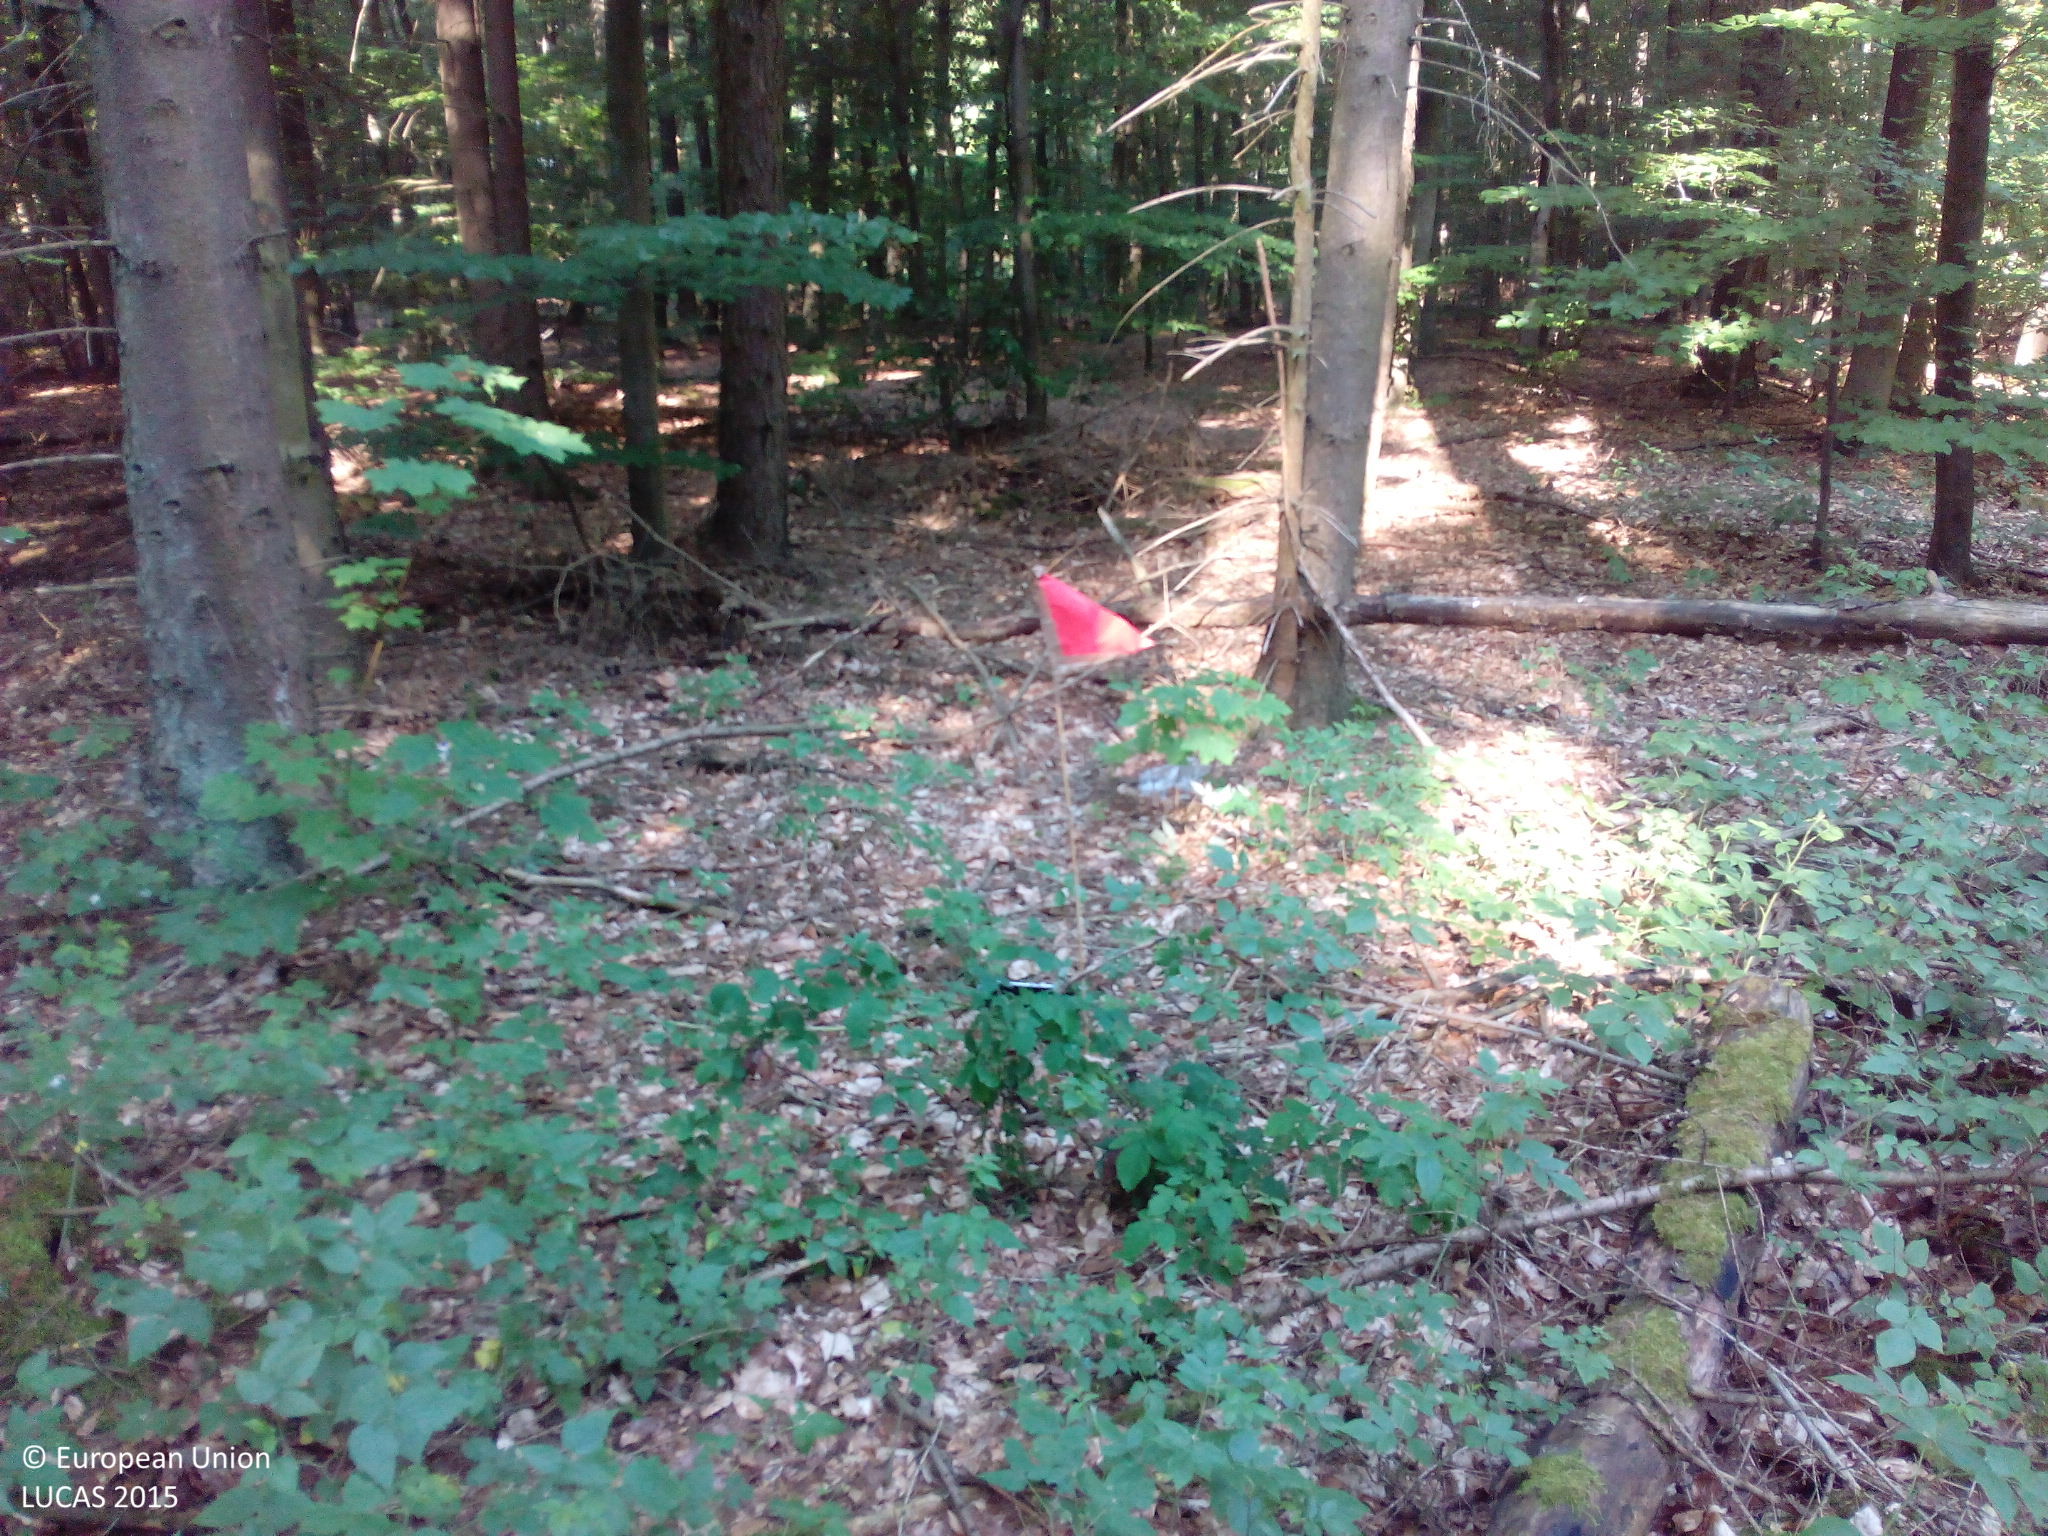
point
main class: Woodland
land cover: Other mixed woodland
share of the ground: > 75 %
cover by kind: coniferous forest trees 75 %, broadleaved forest trees 25 %
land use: Forestry
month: July
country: DE
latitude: 49.2656
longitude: 7.1007
